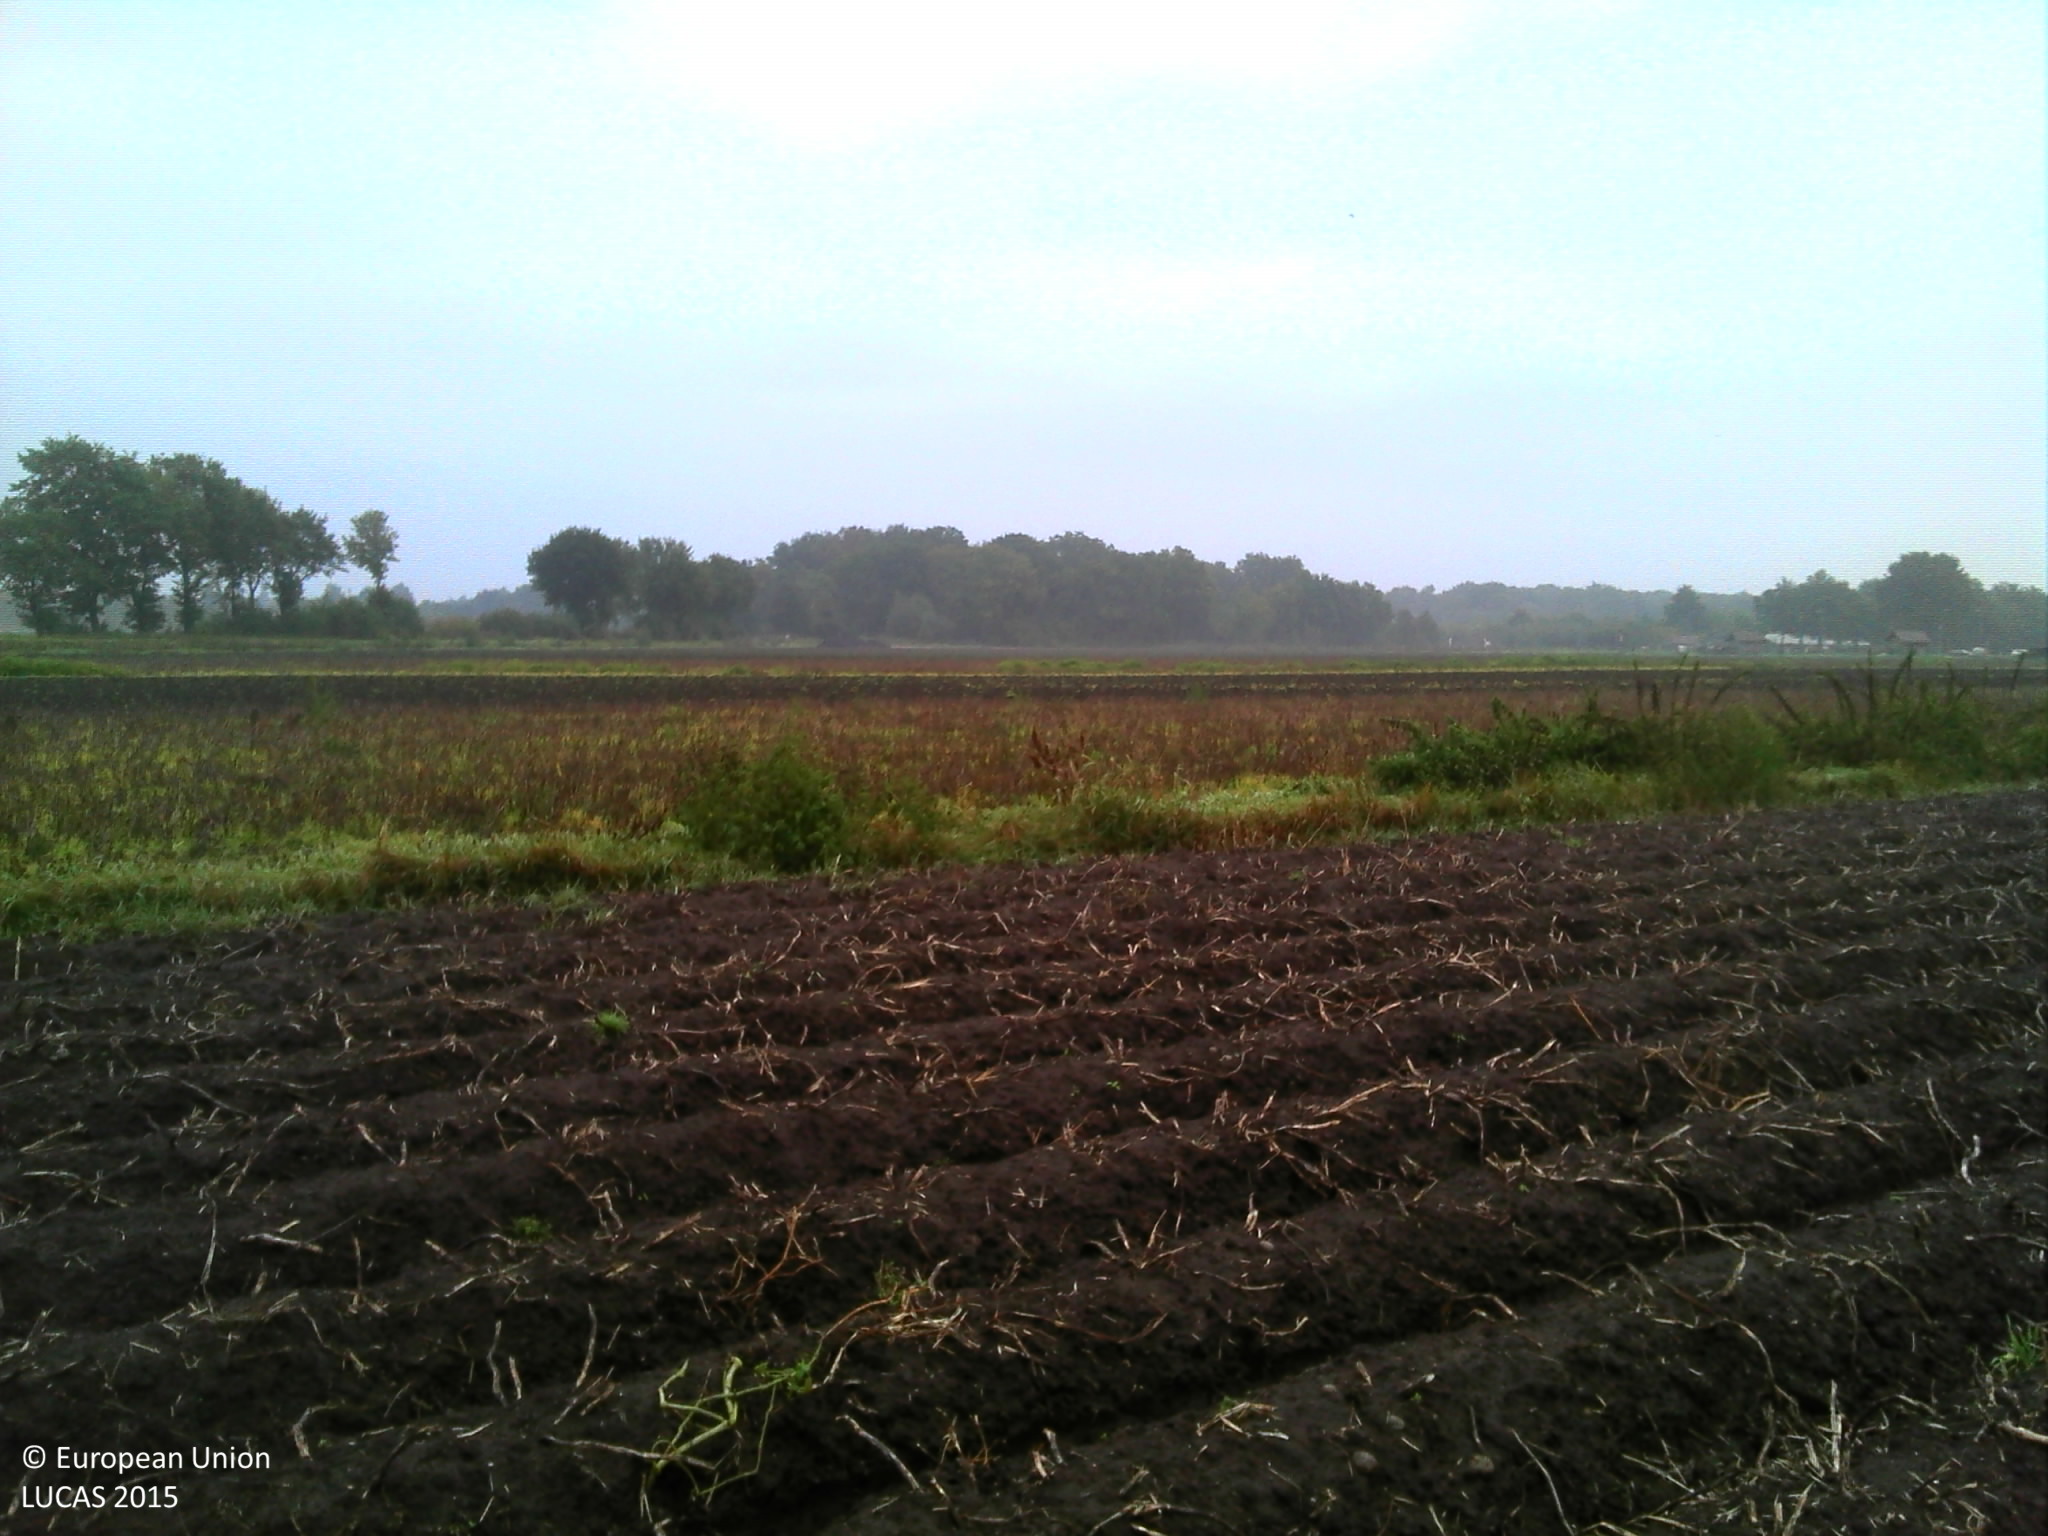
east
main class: Cropland
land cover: Potatoes
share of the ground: 10 - 25 %
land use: Agriculture (excluding fallow land and kitchen gardens)
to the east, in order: Potatoes; Ditches and canals; Grass margins; Spontaneously vegetated surfaces; Other bare soil; Spontaneously vegetated surfaces; Other bare soil
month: October
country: BE
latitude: 51.3435
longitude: 4.3821
